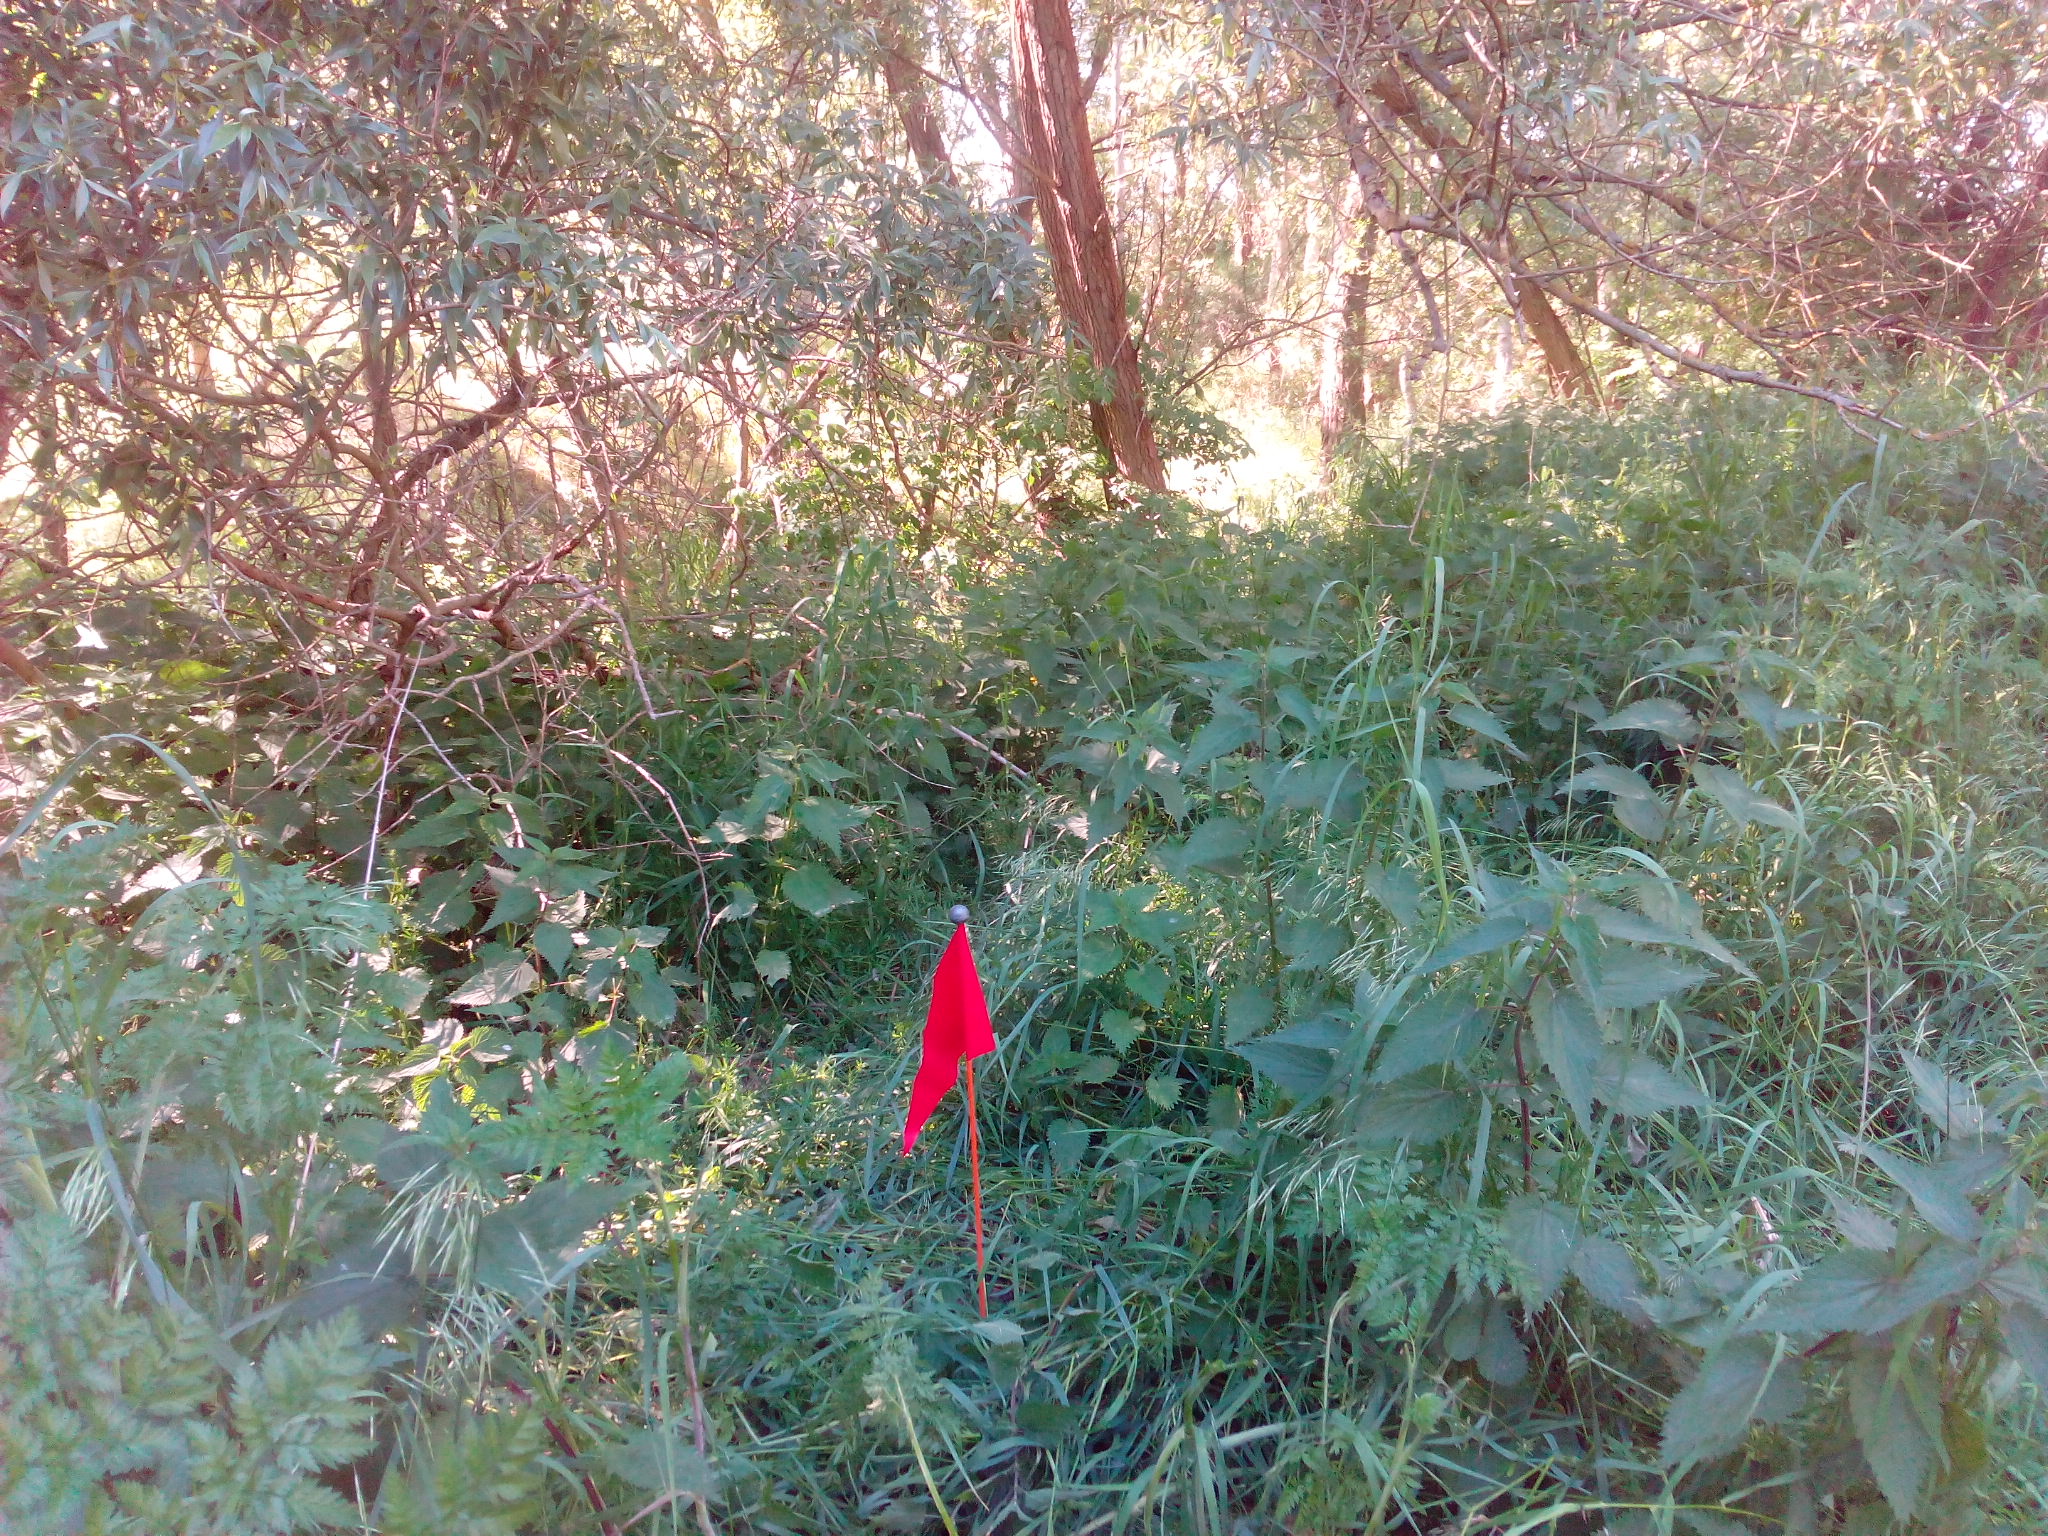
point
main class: Woodland
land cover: Broadleaved woodland
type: mesophytic deciduous forest
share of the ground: 25 - 50 %
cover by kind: broadleaved forest trees 40 %, herbaceous plants 30 %, shrubs 20 %, coniferous forest trees 10 %
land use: Forestry
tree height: > 5 m
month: June
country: DE
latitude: 53.1322
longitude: 14.1708
